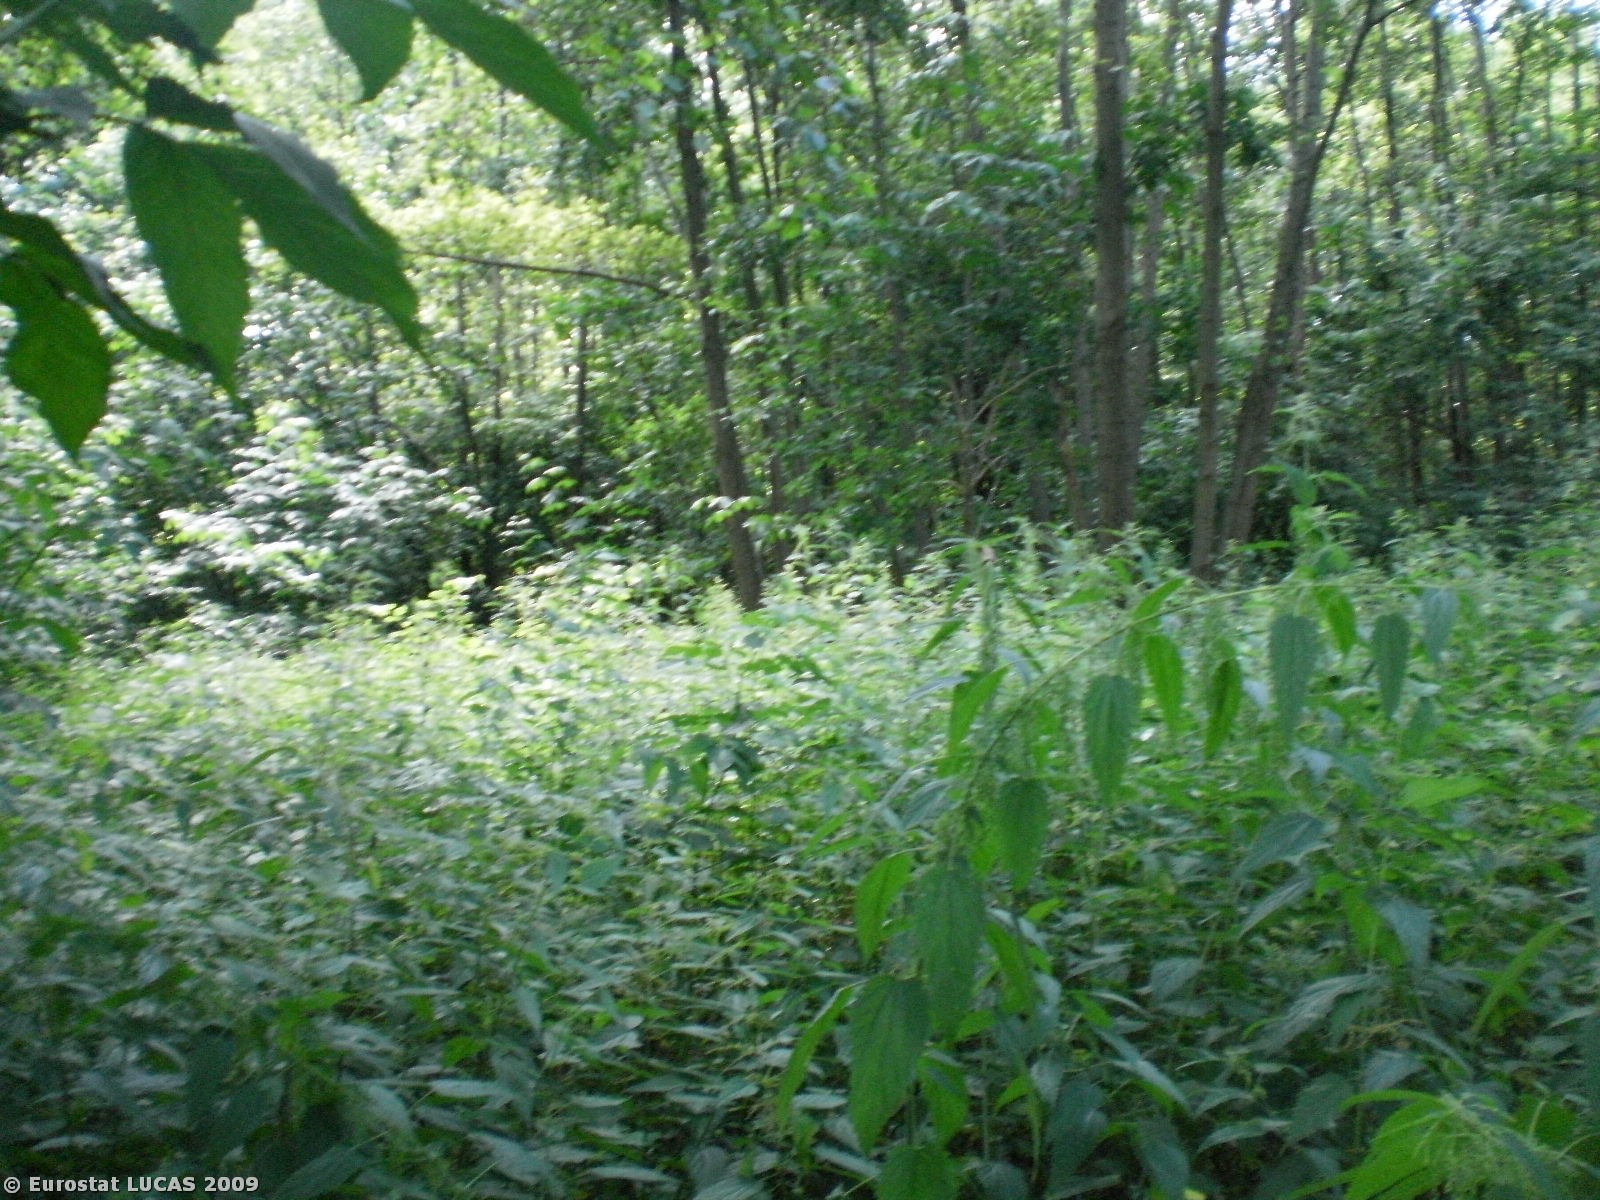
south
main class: Woodland
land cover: Broadleaved woodland
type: mire and swamp forests
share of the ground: > 75 %
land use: Unused
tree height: > 5 m
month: August
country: PL
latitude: 53.8678
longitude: 20.5149
